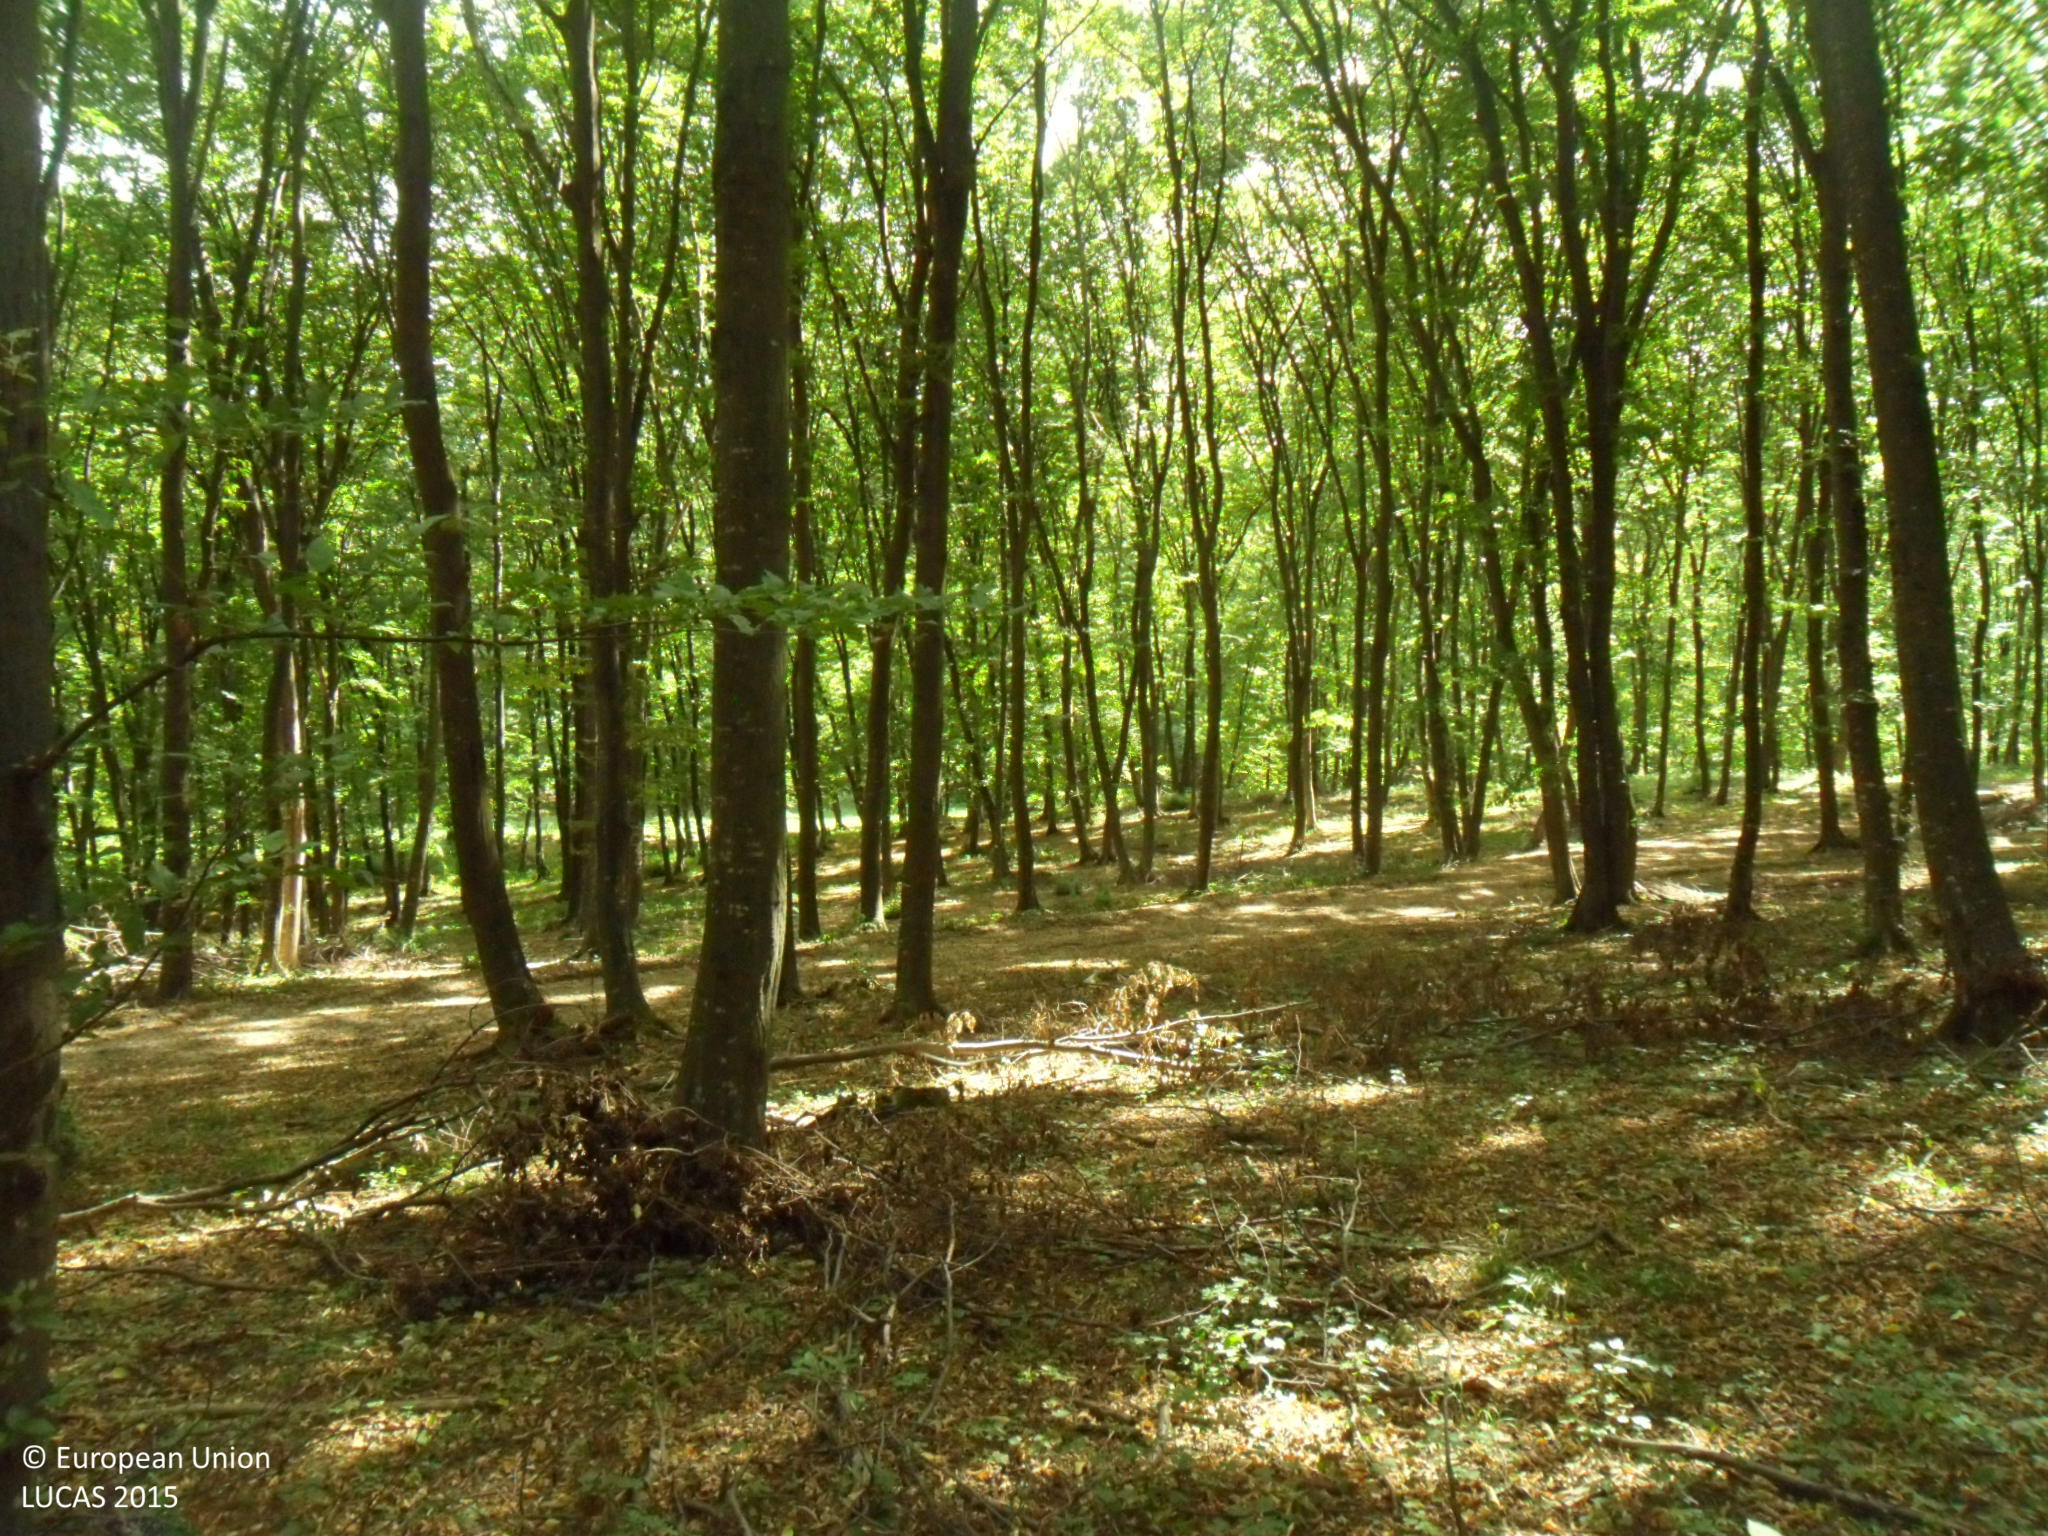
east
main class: Woodland
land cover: Broadleaved woodland
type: beech forest
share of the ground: > 75 %
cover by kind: broadleaved forest trees 100 %
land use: Forestry
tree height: > 5 m
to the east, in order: Broadleaved woodland; Tracks; Broadleaved woodland; Ponds and wetlands; Tracks; Broadleaved woodland; Tracks; Broadleaved woodland; Tracks; Broadleaved woodland
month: September
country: BG
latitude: 43.5684
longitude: 26.2827
